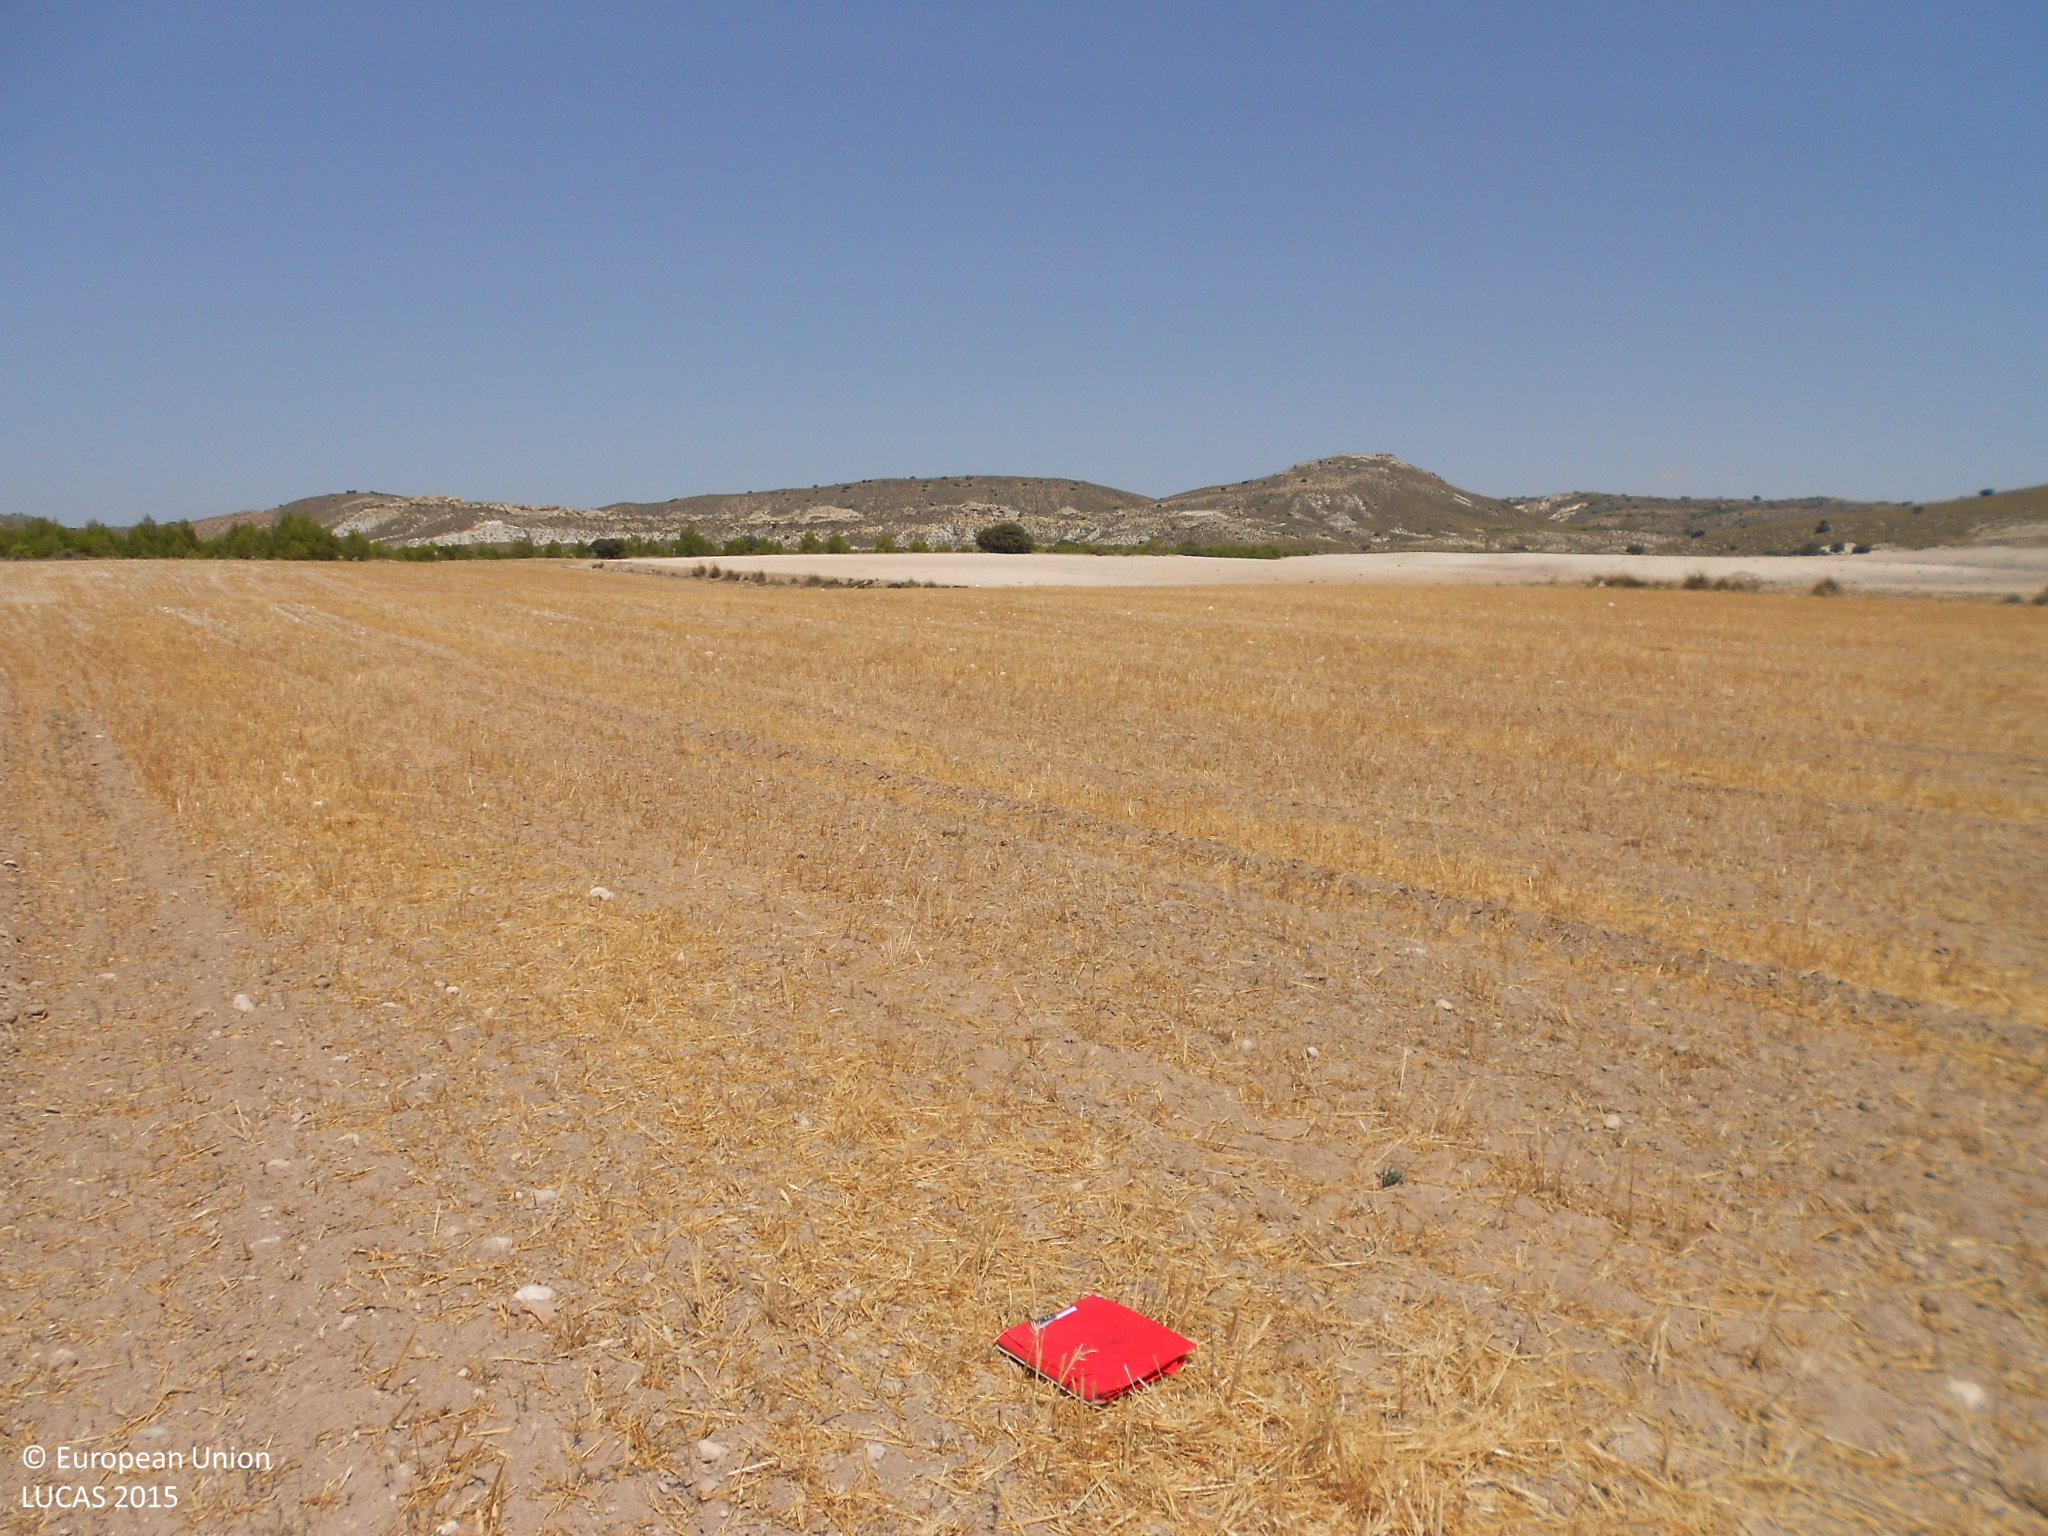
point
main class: Cropland
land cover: Oats
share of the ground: < 10 %
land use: Agriculture (excluding fallow land and kitchen gardens)
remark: Harvested field
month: August
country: ES
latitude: 37.7308
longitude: -2.3209
